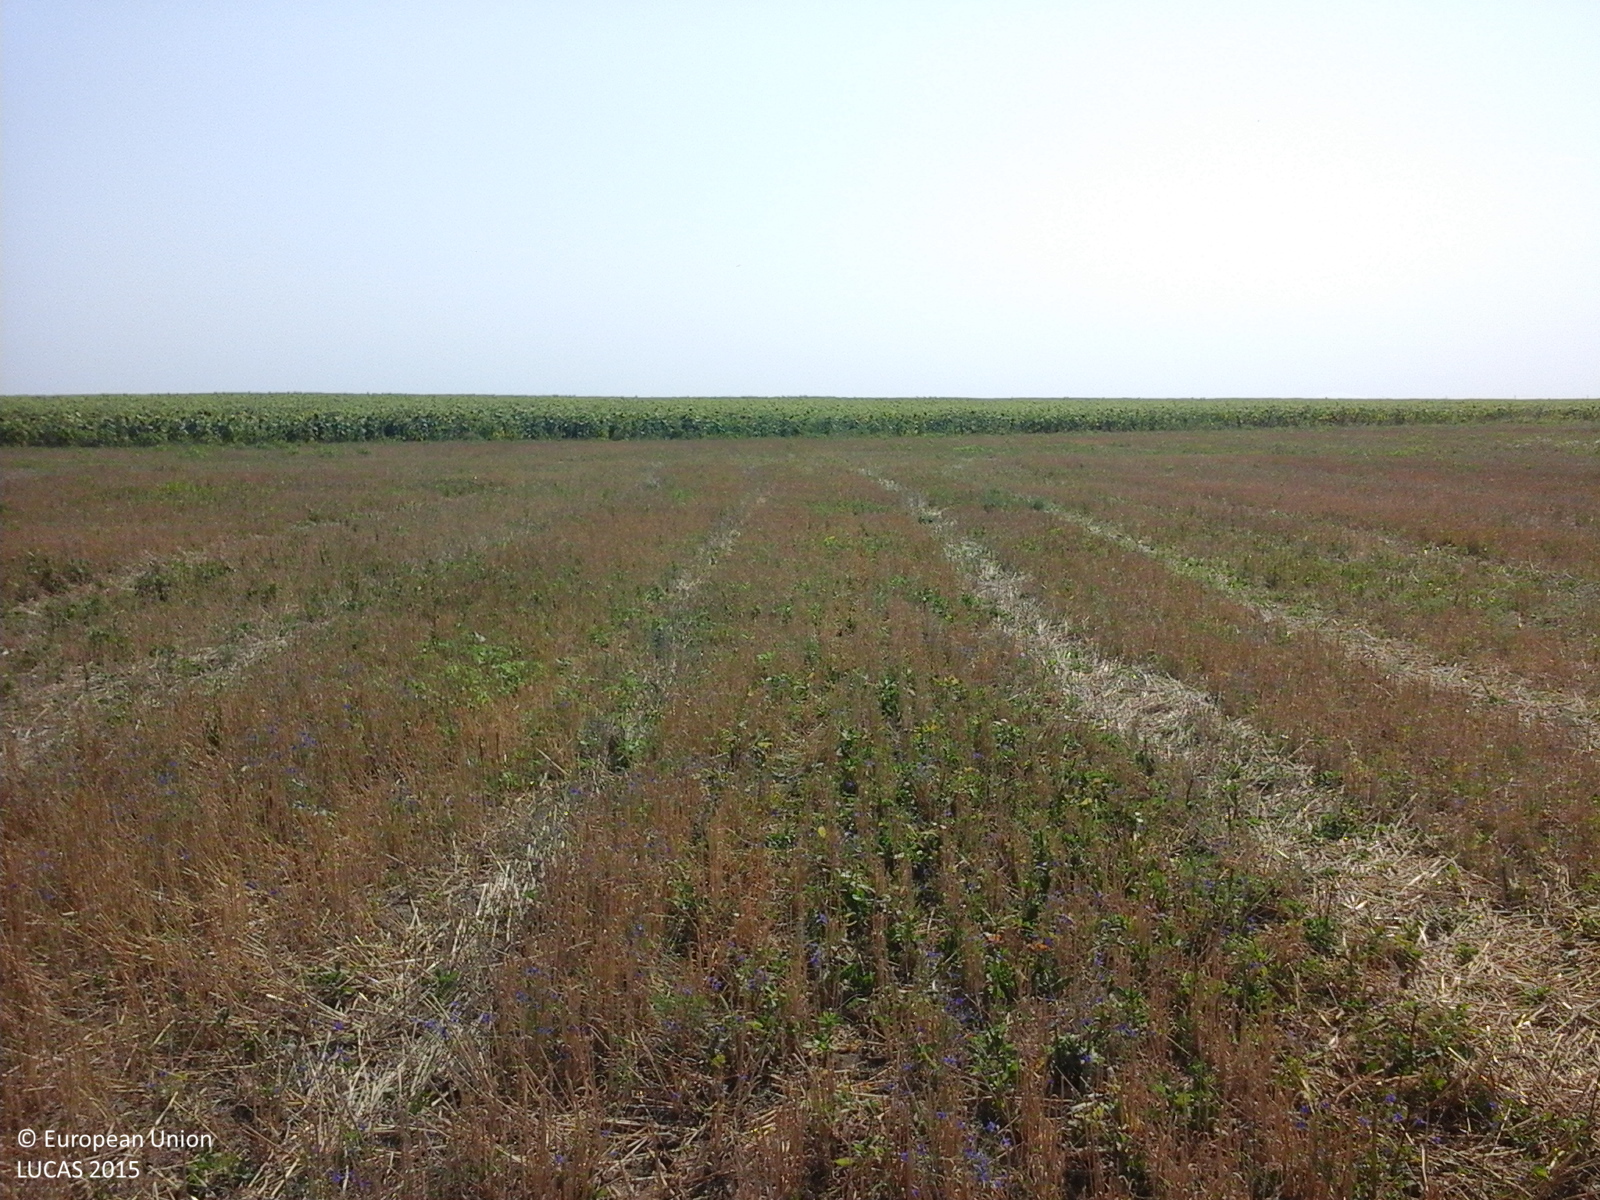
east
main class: Cropland
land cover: Common wheat
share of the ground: > 75 %
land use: Agriculture (excluding fallow land and kitchen gardens)
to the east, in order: Common wheat; Sunflower
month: August
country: RO
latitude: 45.3767
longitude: 27.5856
